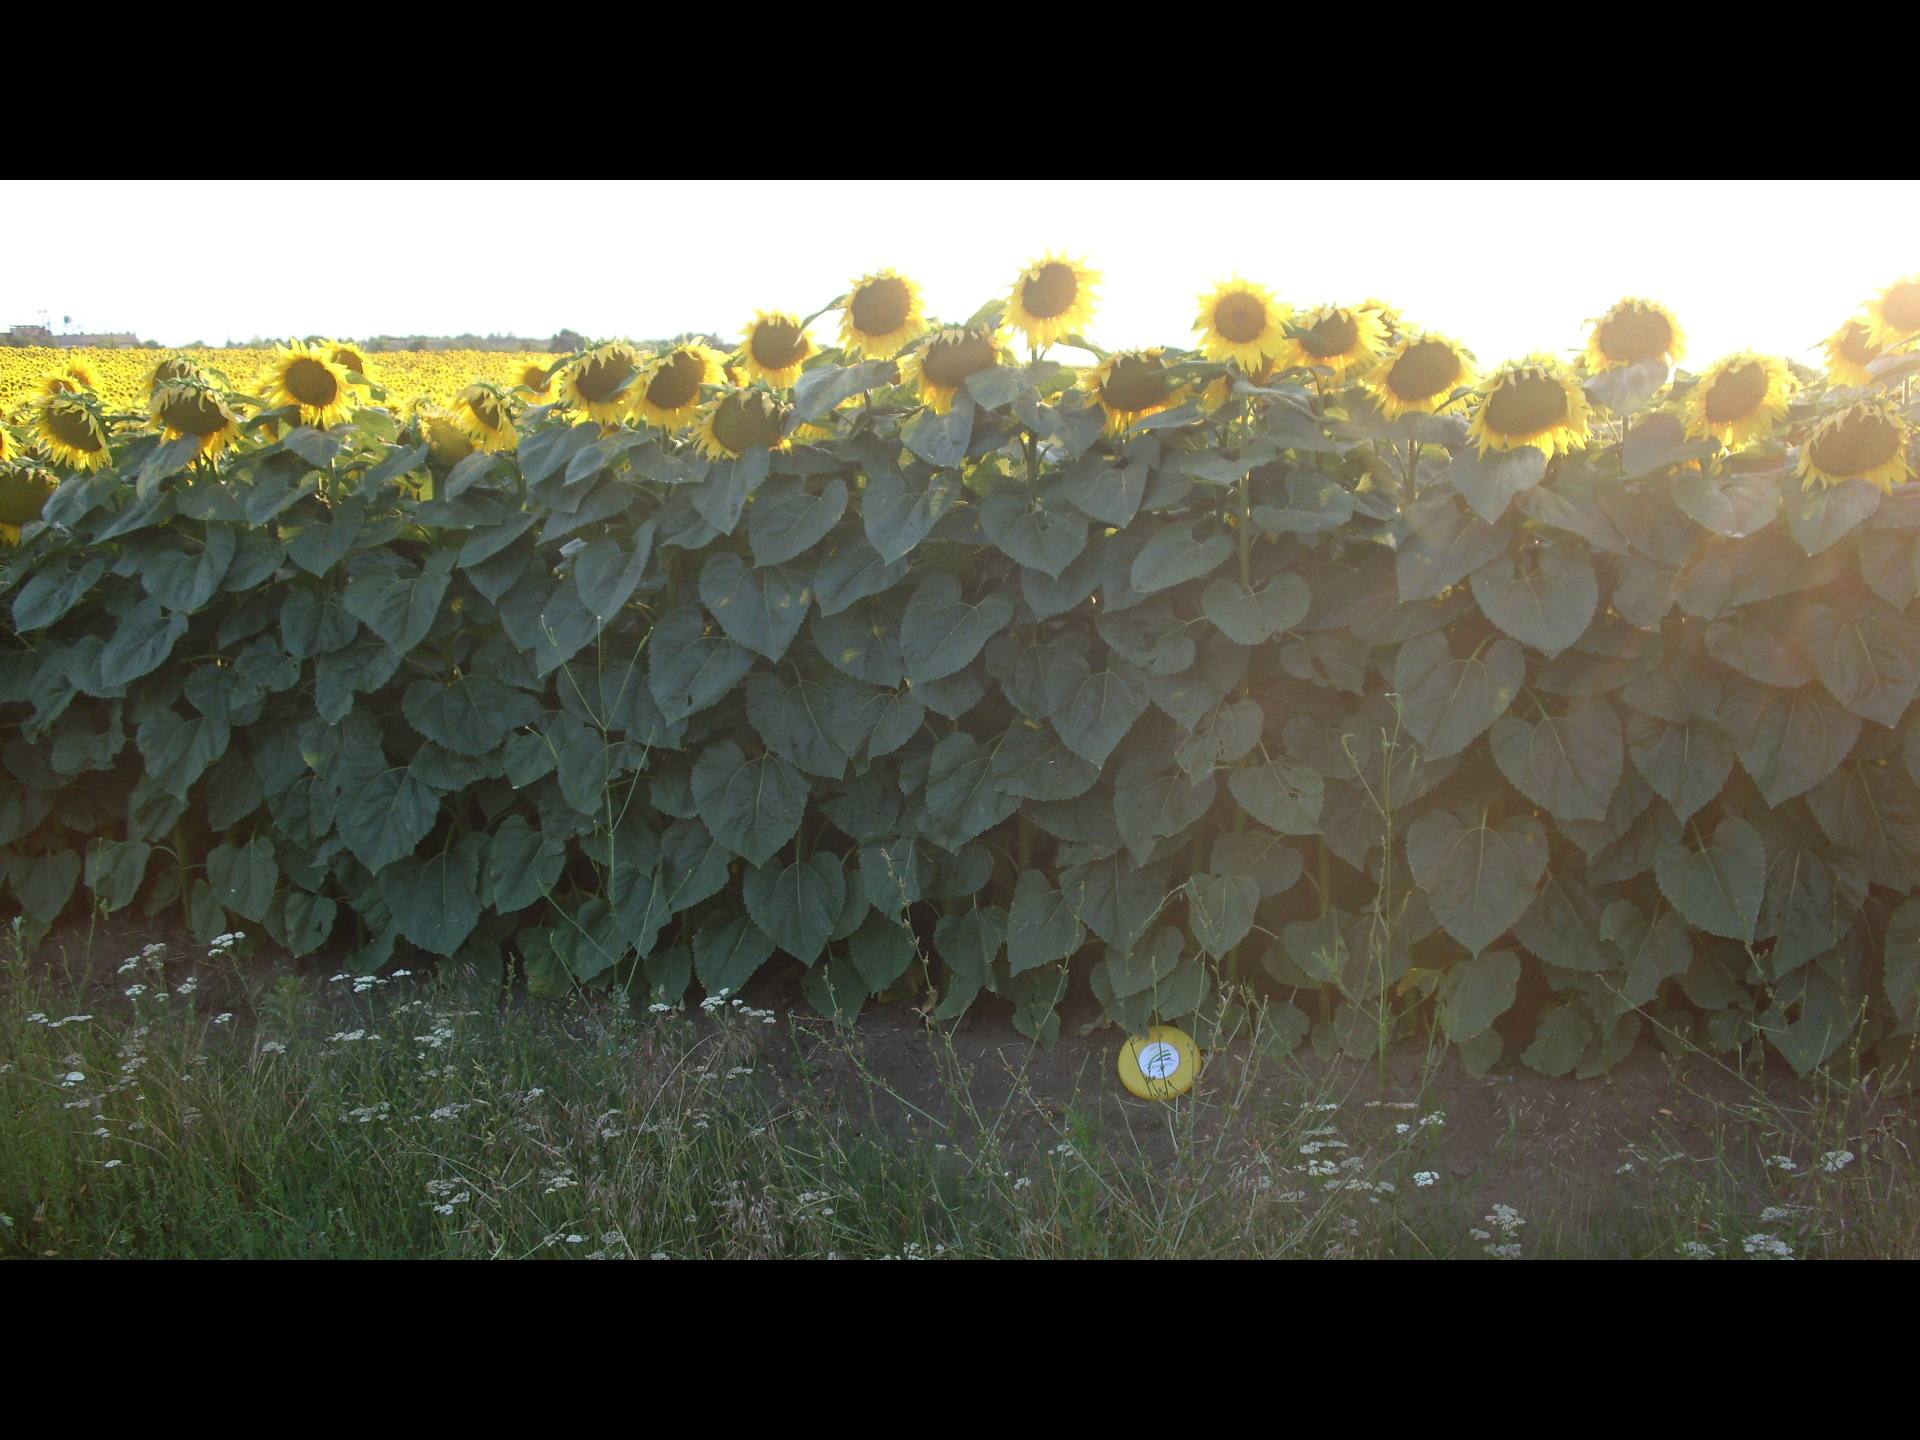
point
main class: Cropland
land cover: Sunflower
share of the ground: > 75 %
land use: Agriculture (excluding fallow land and kitchen gardens)
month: July
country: BG
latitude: 43.7238
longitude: 23.1877
